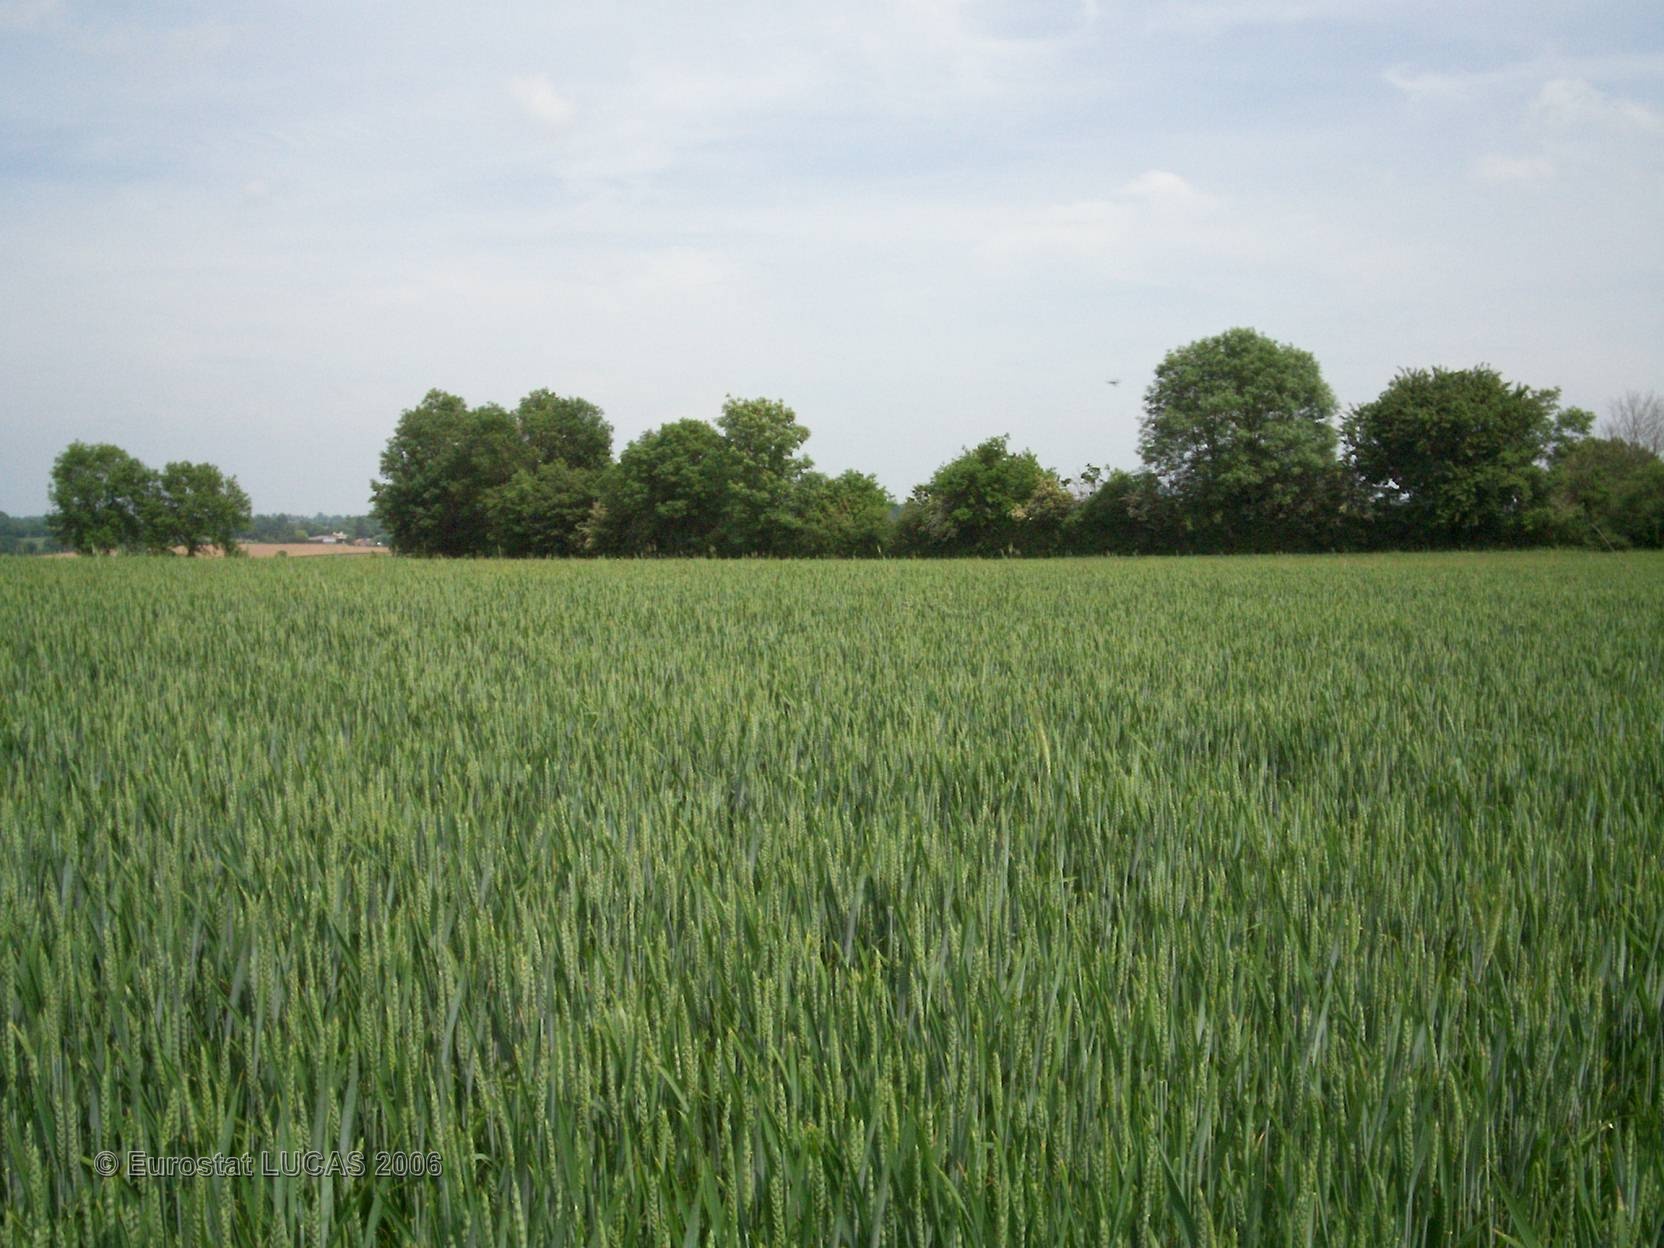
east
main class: Cropland
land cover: Common wheat
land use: Agriculture (excluding fallow land and kitchen gardens)
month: May
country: FR
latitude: 46.4698
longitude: -0.2996
